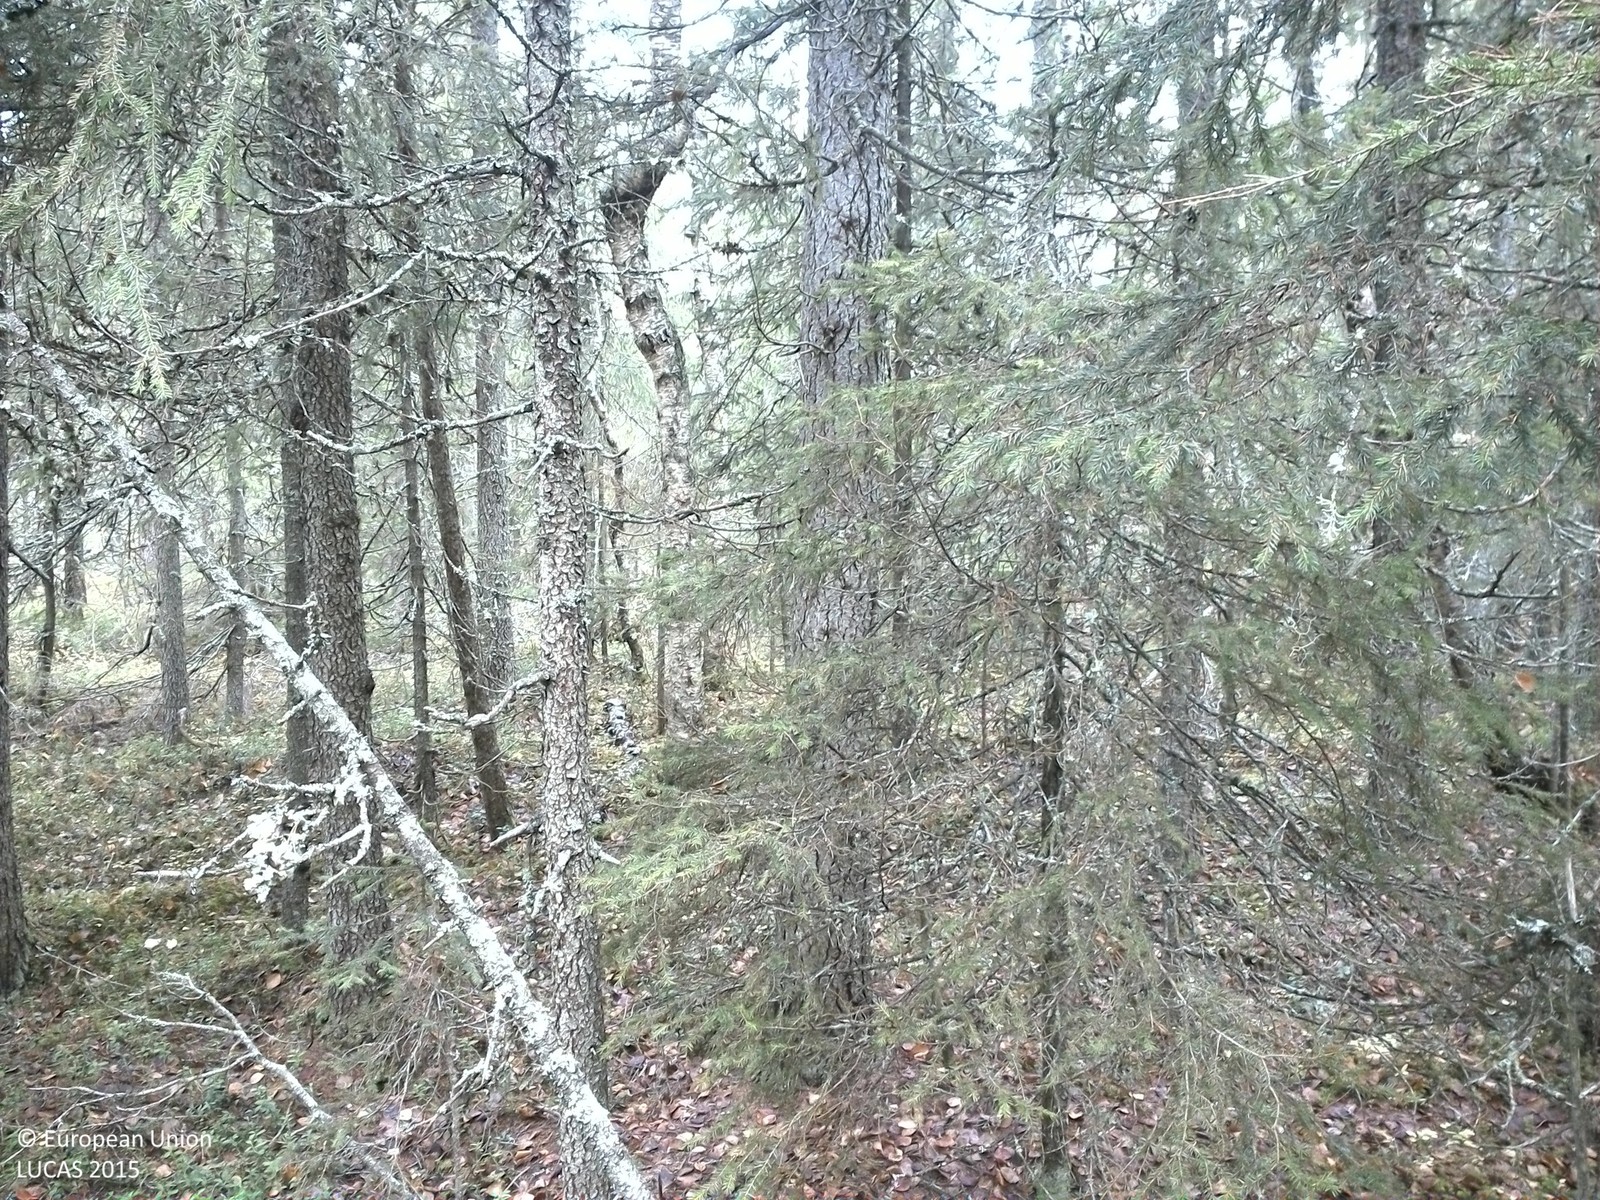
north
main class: Woodland
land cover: Spruce dominated mixed woodland
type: boreal forest
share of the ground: 50 - 75 %
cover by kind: coniferous forest trees 50 %, broadleaved forest trees 20 %, shrubs 20 %, lichens and mosses 10 %
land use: Forestry
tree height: > 5 m
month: October
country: SE
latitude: 64.1221
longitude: 15.9878
